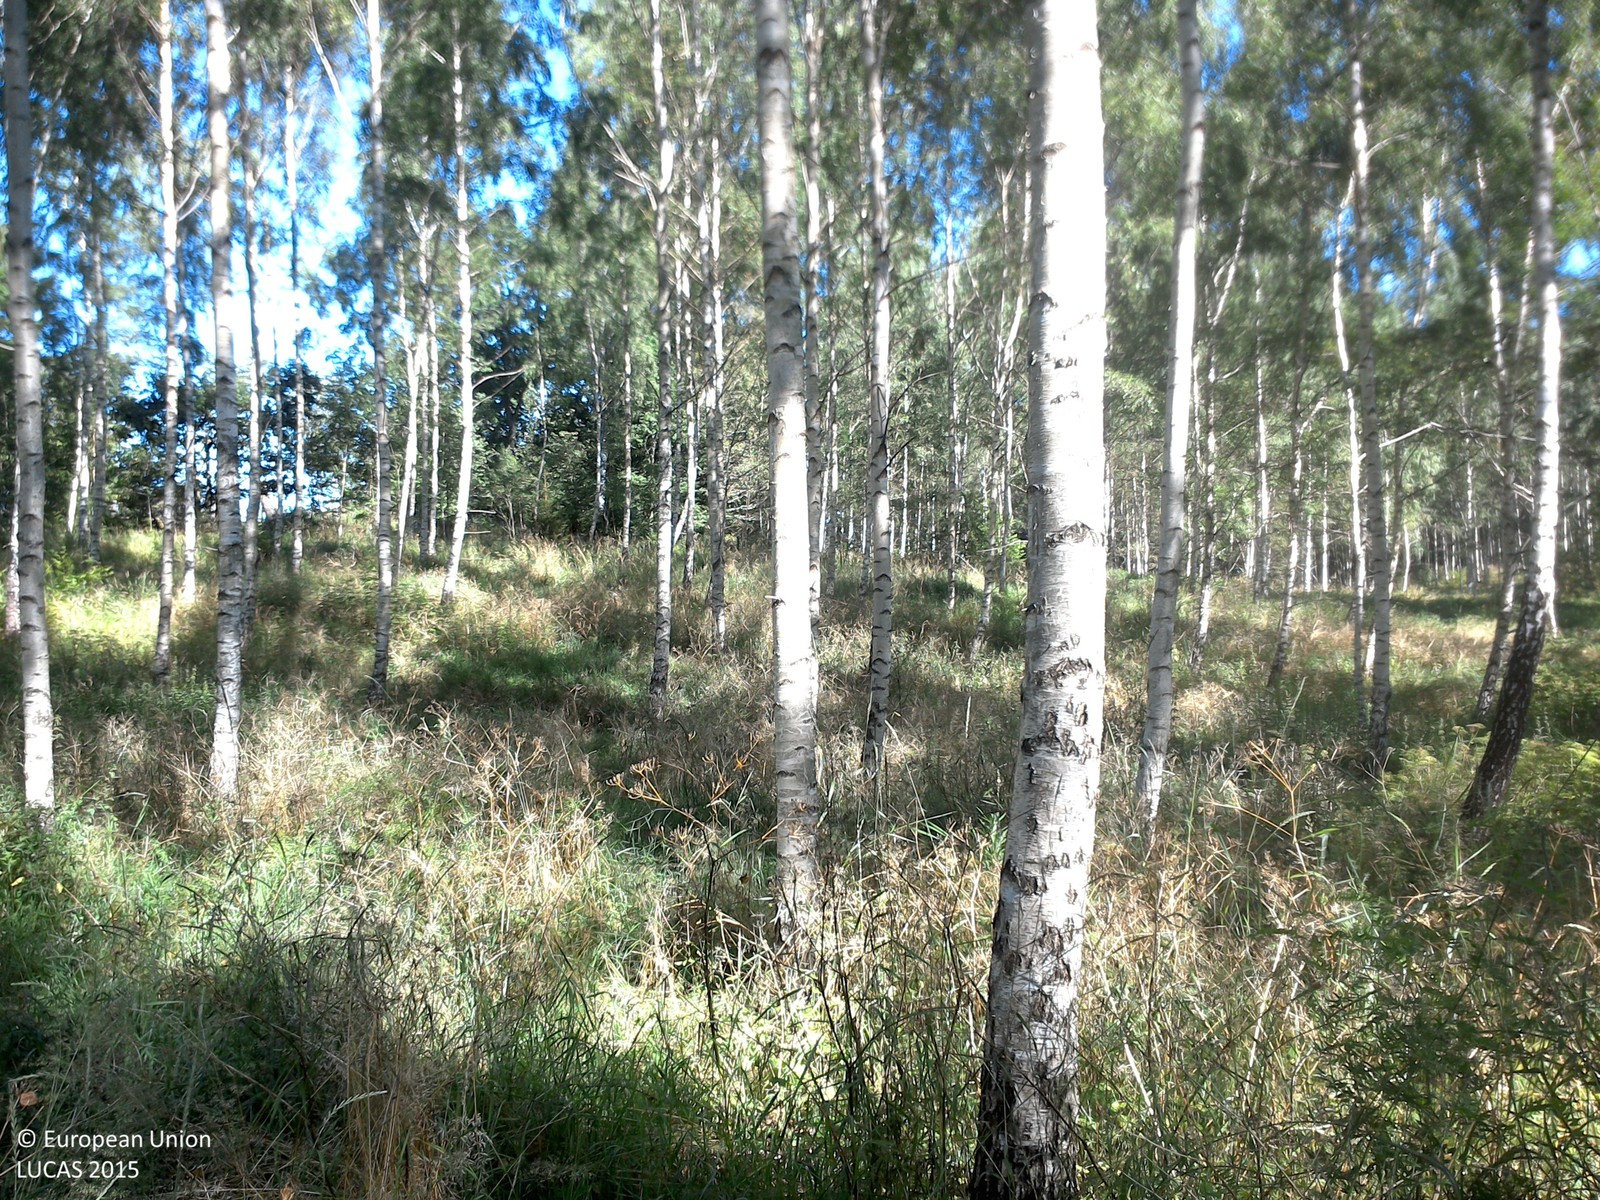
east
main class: Woodland
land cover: Broadleaved woodland
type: hemiboreal forest and nemoral coniferous forest and mixed broadleaved-coniferous forest
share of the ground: 25 - 50 %
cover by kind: herbaceous plants 60 %, broadleaved forest trees 40 %
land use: Forestry
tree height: > 5 m
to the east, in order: Broadleaved woodland; Paved roads, cycling and walking lanes; Broadleaved woodland; Fences; Broadleaved woodland; Rivers and streams; Broadleaved woodland; Fences; Grassland without tree/shrub cover
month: August
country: SE
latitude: 58.2429
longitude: 15.2583
